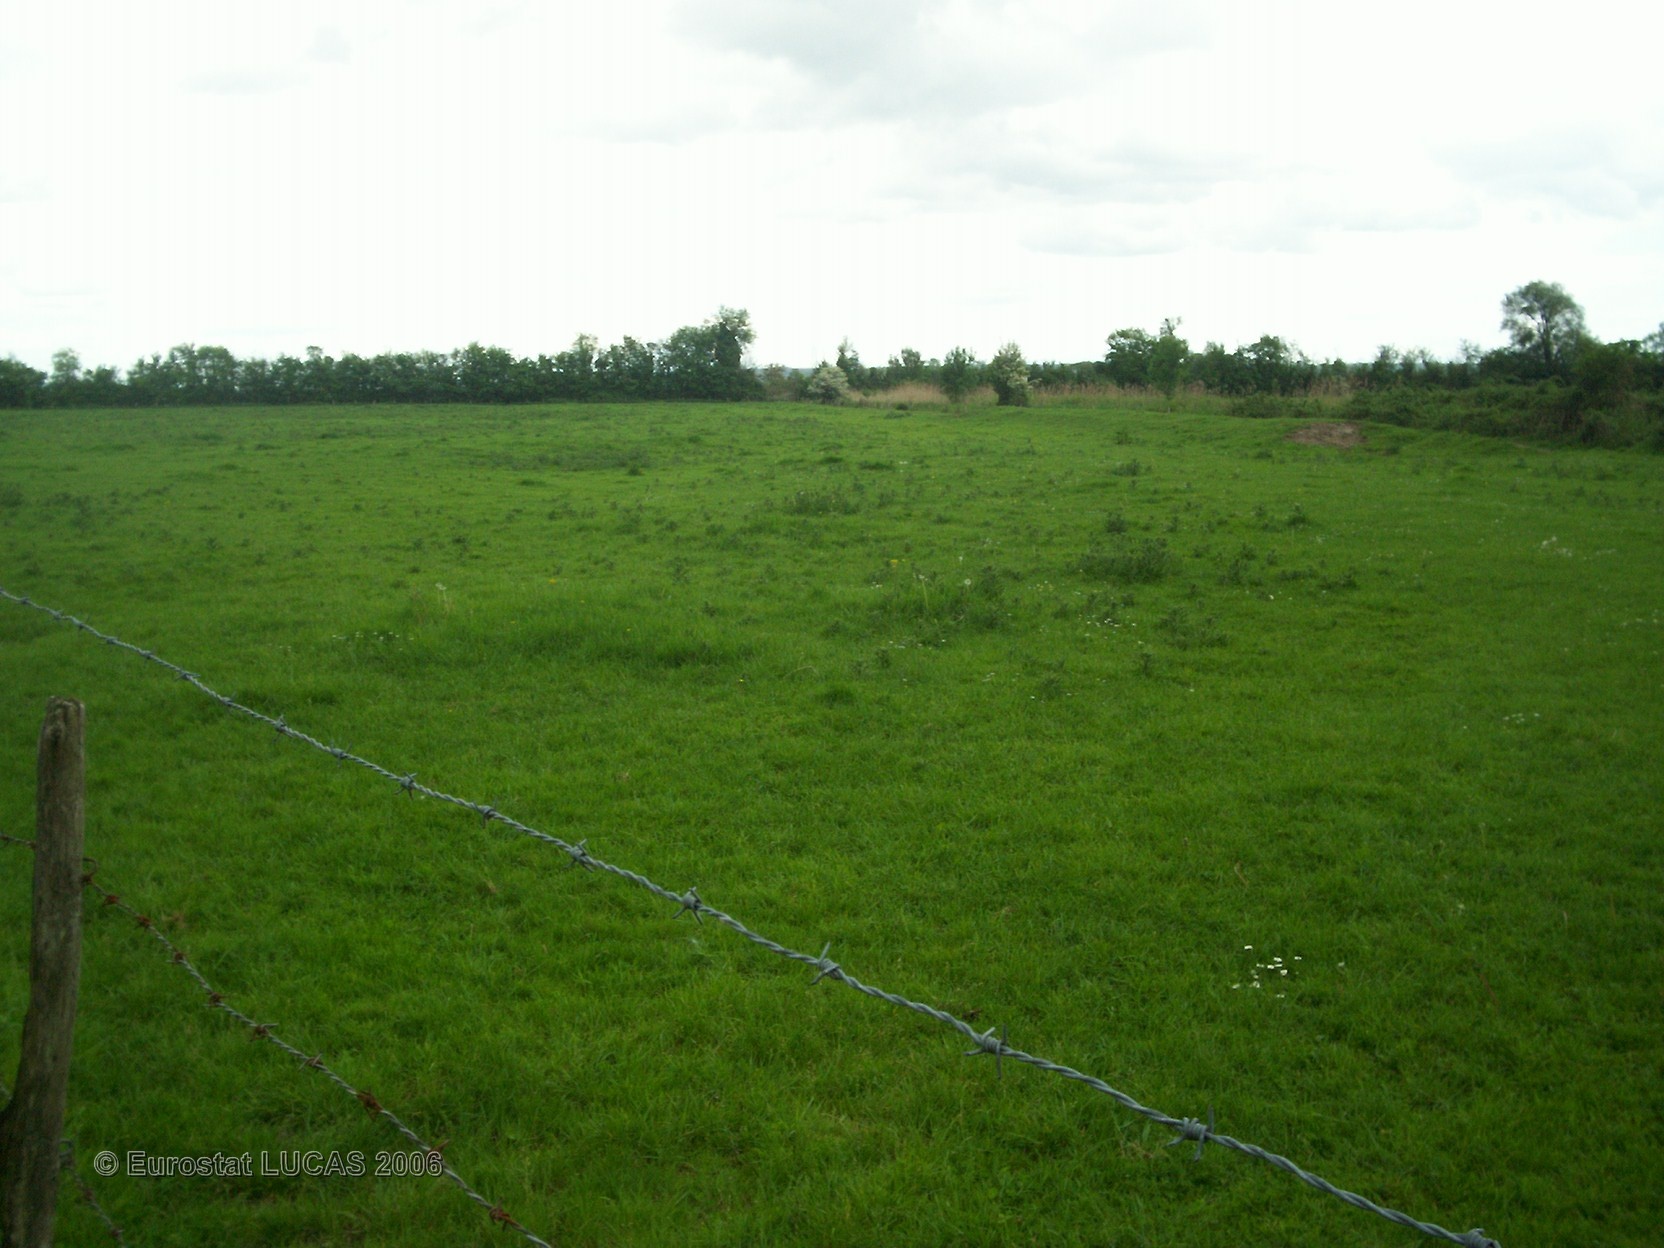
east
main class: Grassland
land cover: Grassland without tree/shrub cover
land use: Agriculture (excluding fallow land and kitchen gardens)
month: May
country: FR
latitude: 49.4379
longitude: 0.4437
